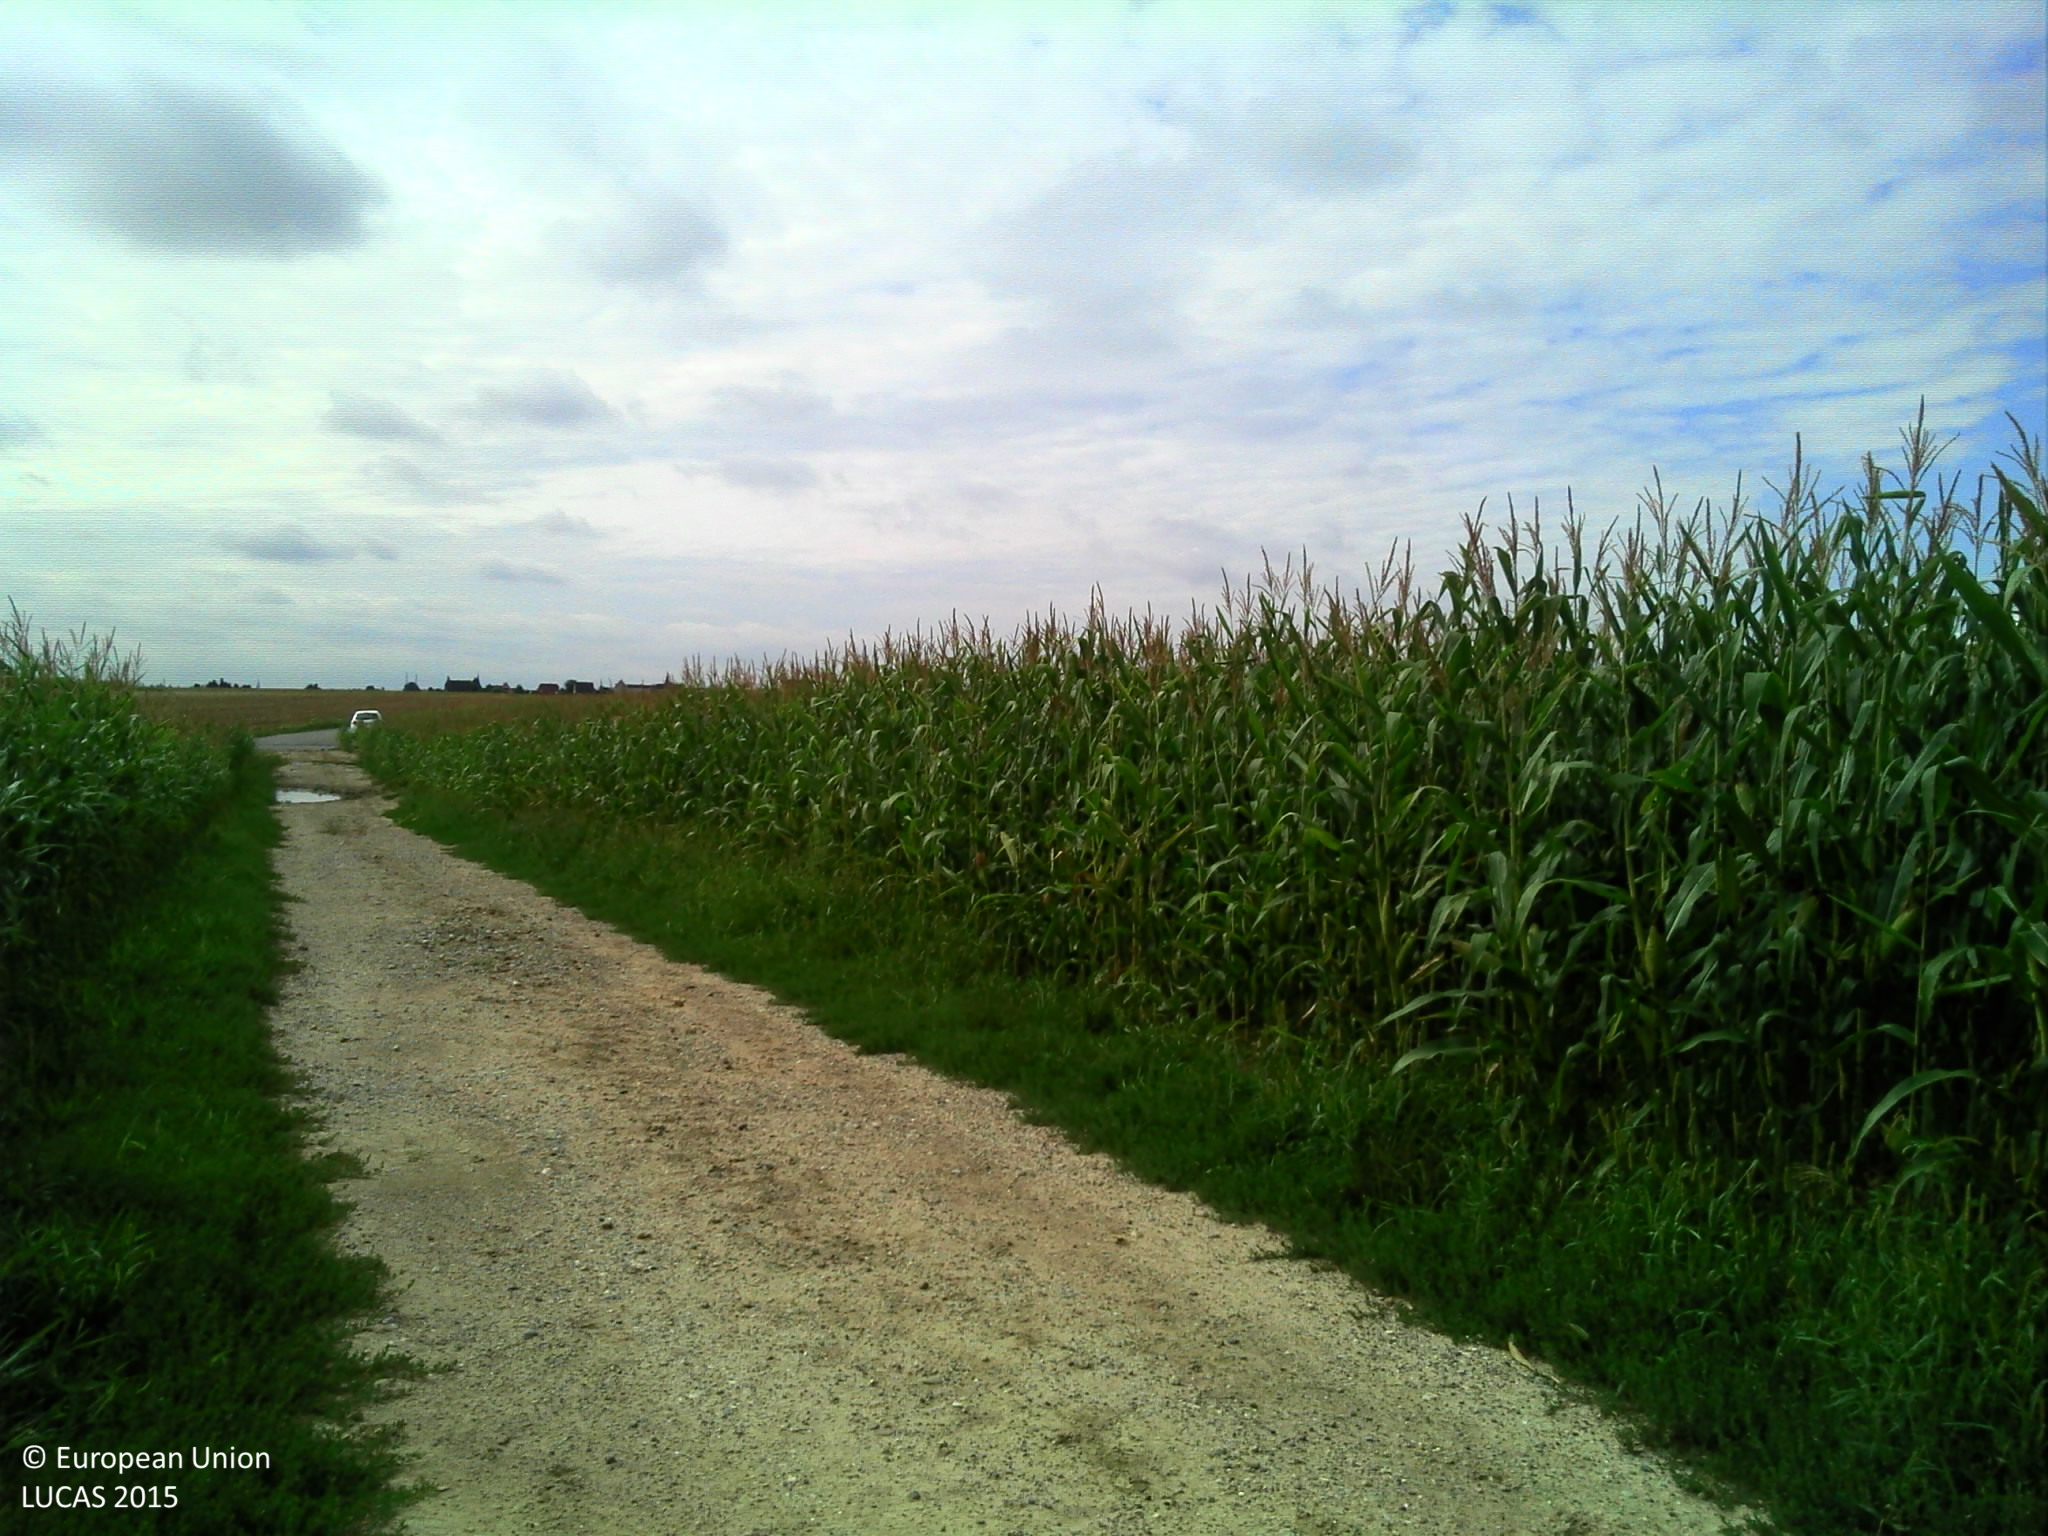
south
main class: Cropland
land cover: Maize
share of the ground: > 75 %
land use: Agriculture (excluding fallow land and kitchen gardens)
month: August
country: FR
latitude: 48.6857
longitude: 7.7052
